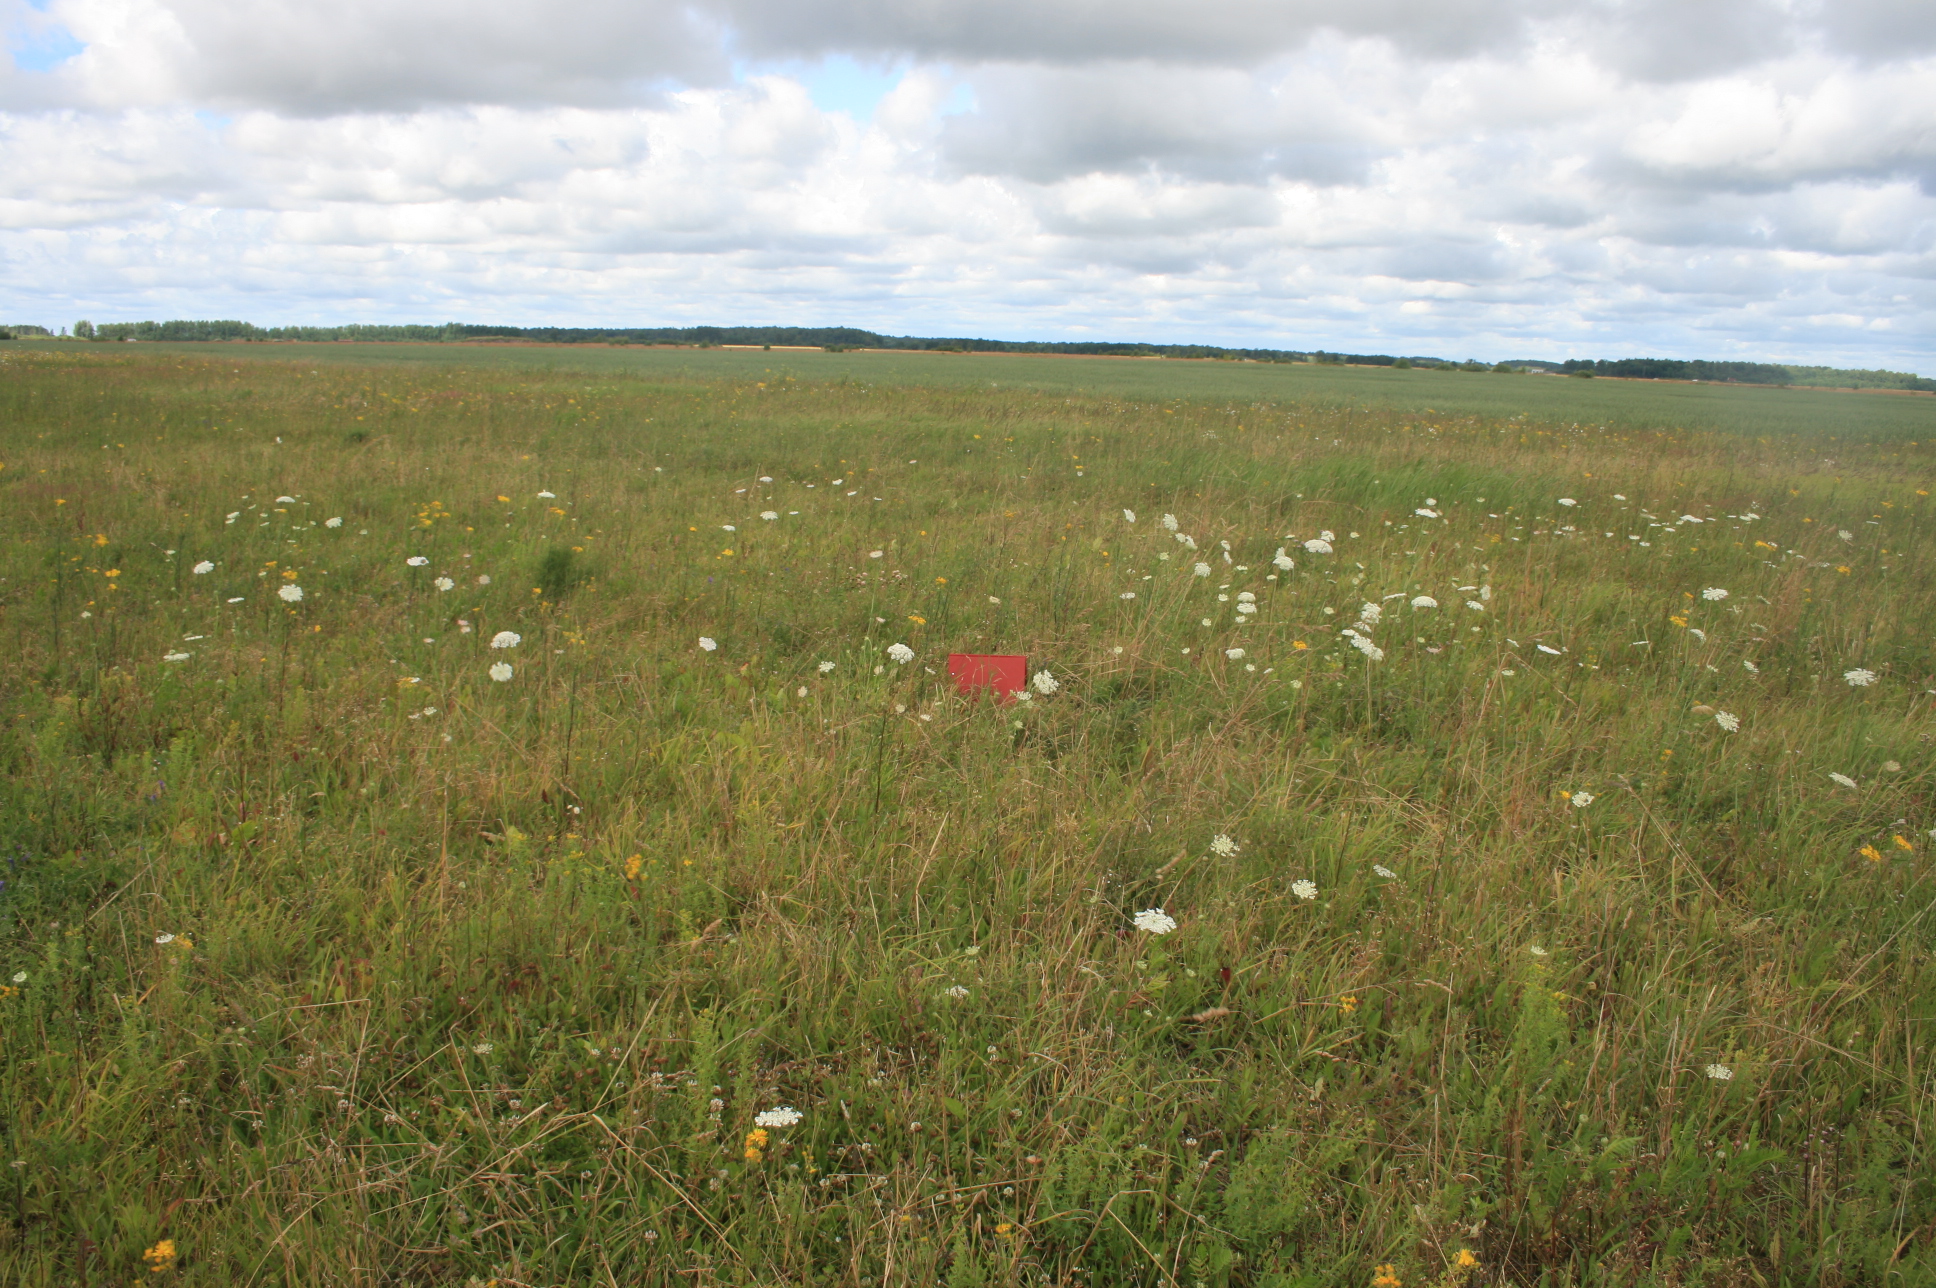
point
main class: Grassland
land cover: Grassland without tree/shrub cover
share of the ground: > 75 %
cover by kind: herbaceous plants 100 %
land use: Agriculture (excluding fallow land and kitchen gardens)
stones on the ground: < 10 %
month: July
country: LT
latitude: 55.7467
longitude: 21.2407
